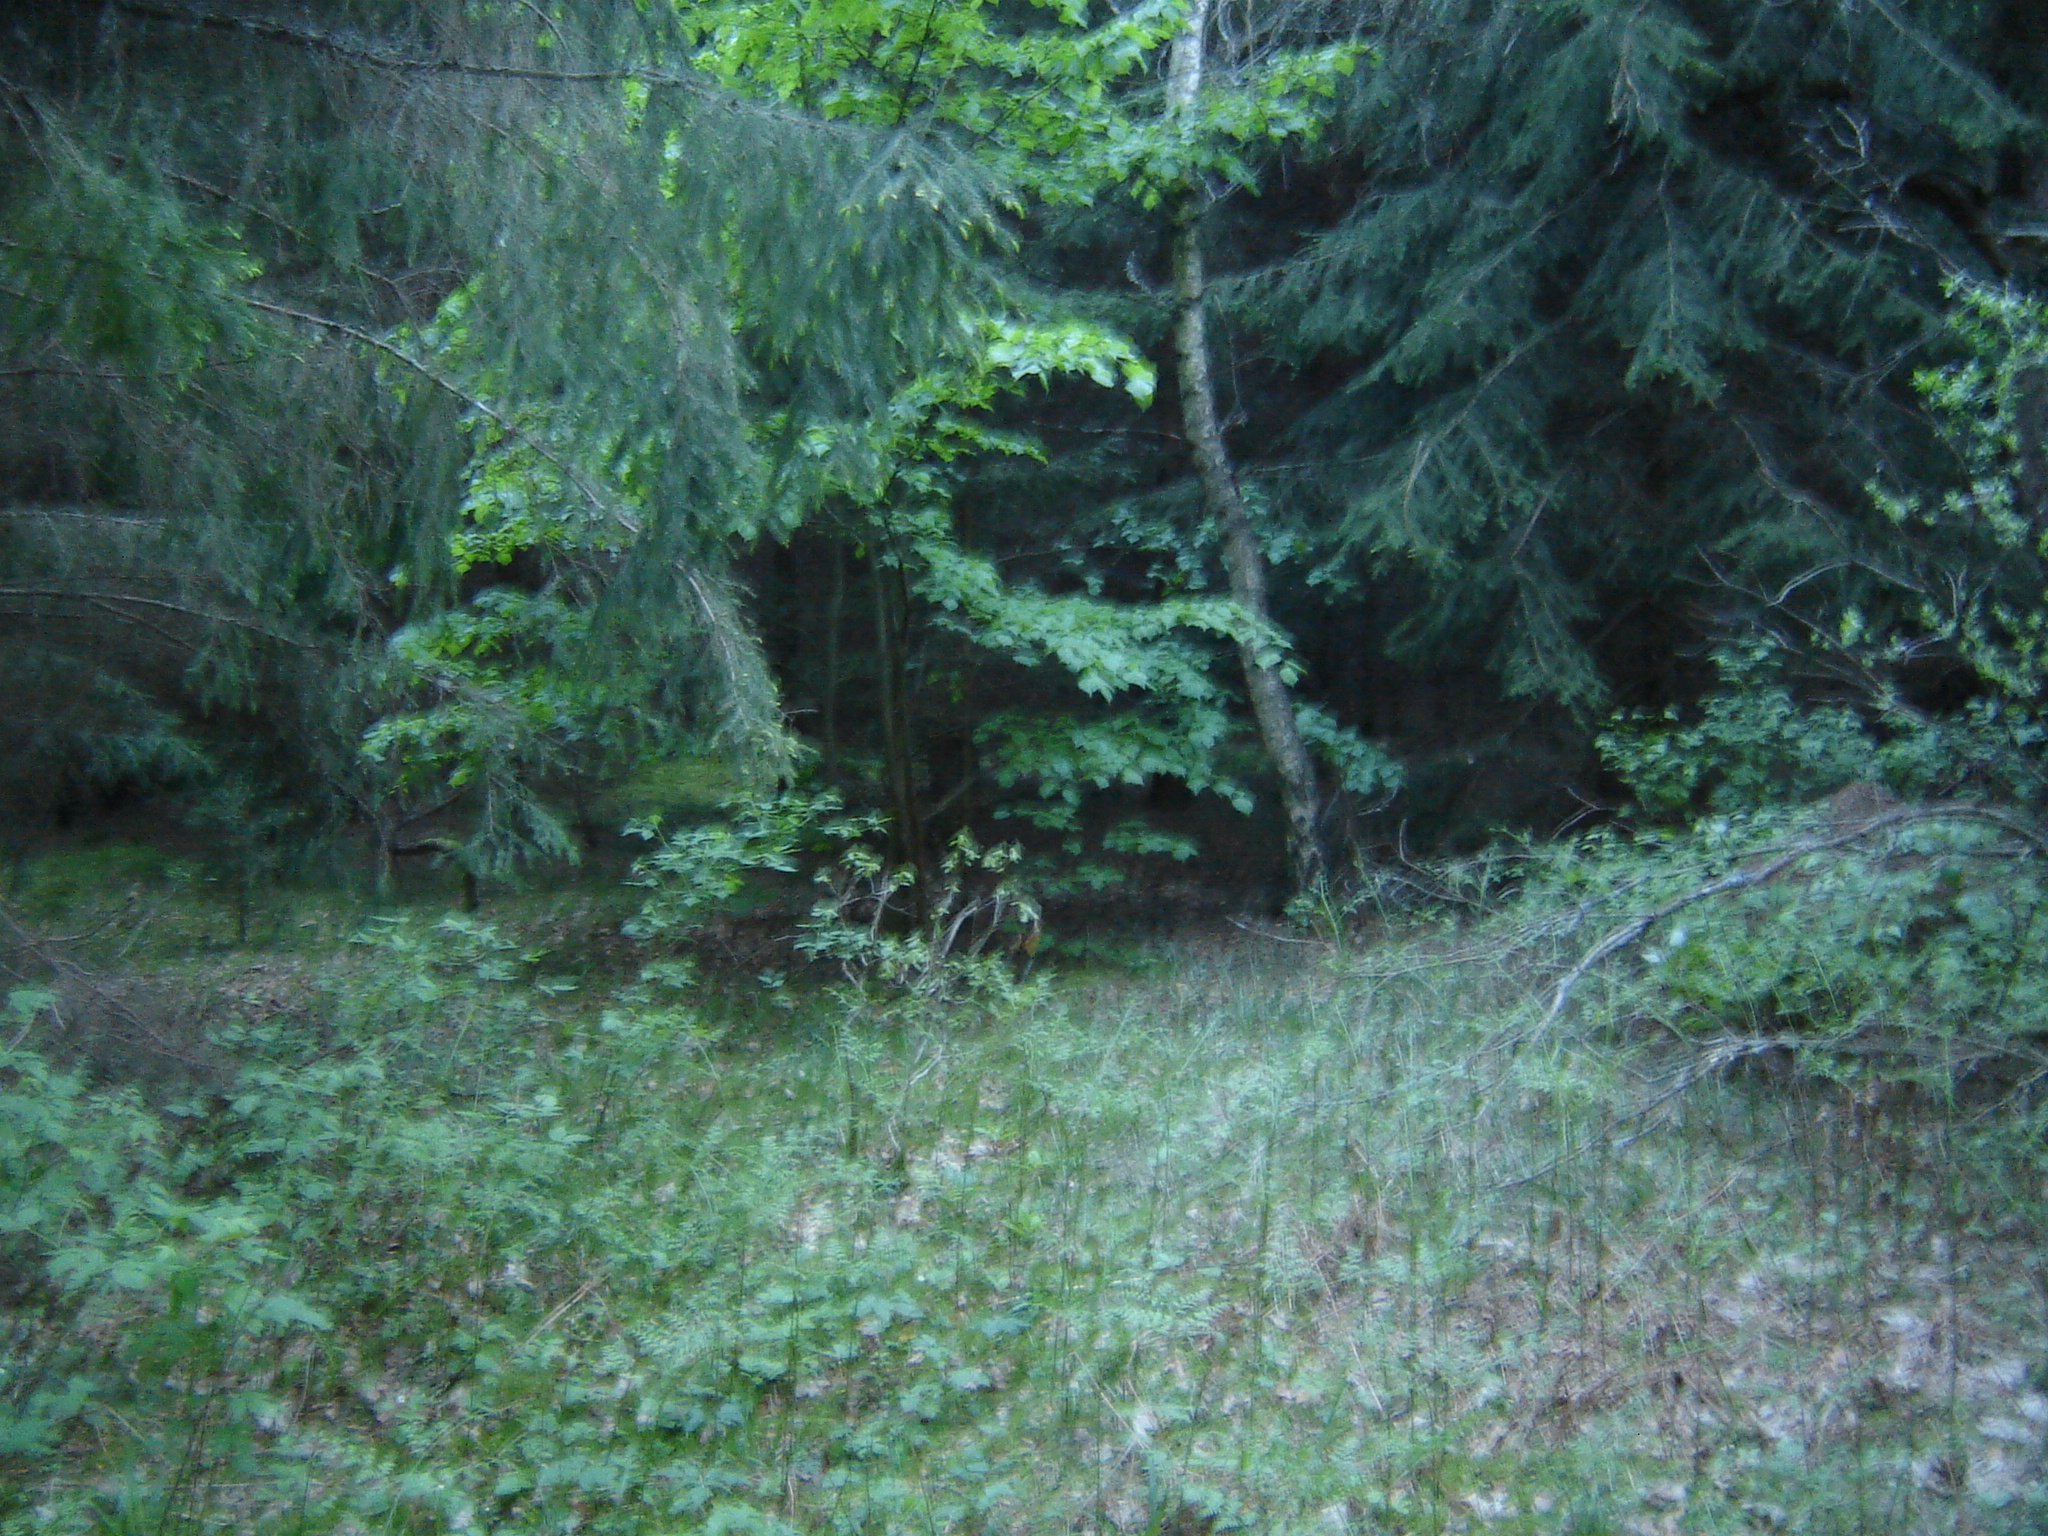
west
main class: Woodland
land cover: Spruce dominated mixed woodland
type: hemiboreal forest and nemoral coniferous forest and mixed broadleaved-coniferous forest
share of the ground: > 75 %
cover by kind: coniferous forest trees 60 %, broadleaved forest trees 40 %
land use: Forestry
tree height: > 5 m
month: May
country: LT
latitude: 55.7233
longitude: 25.1276
